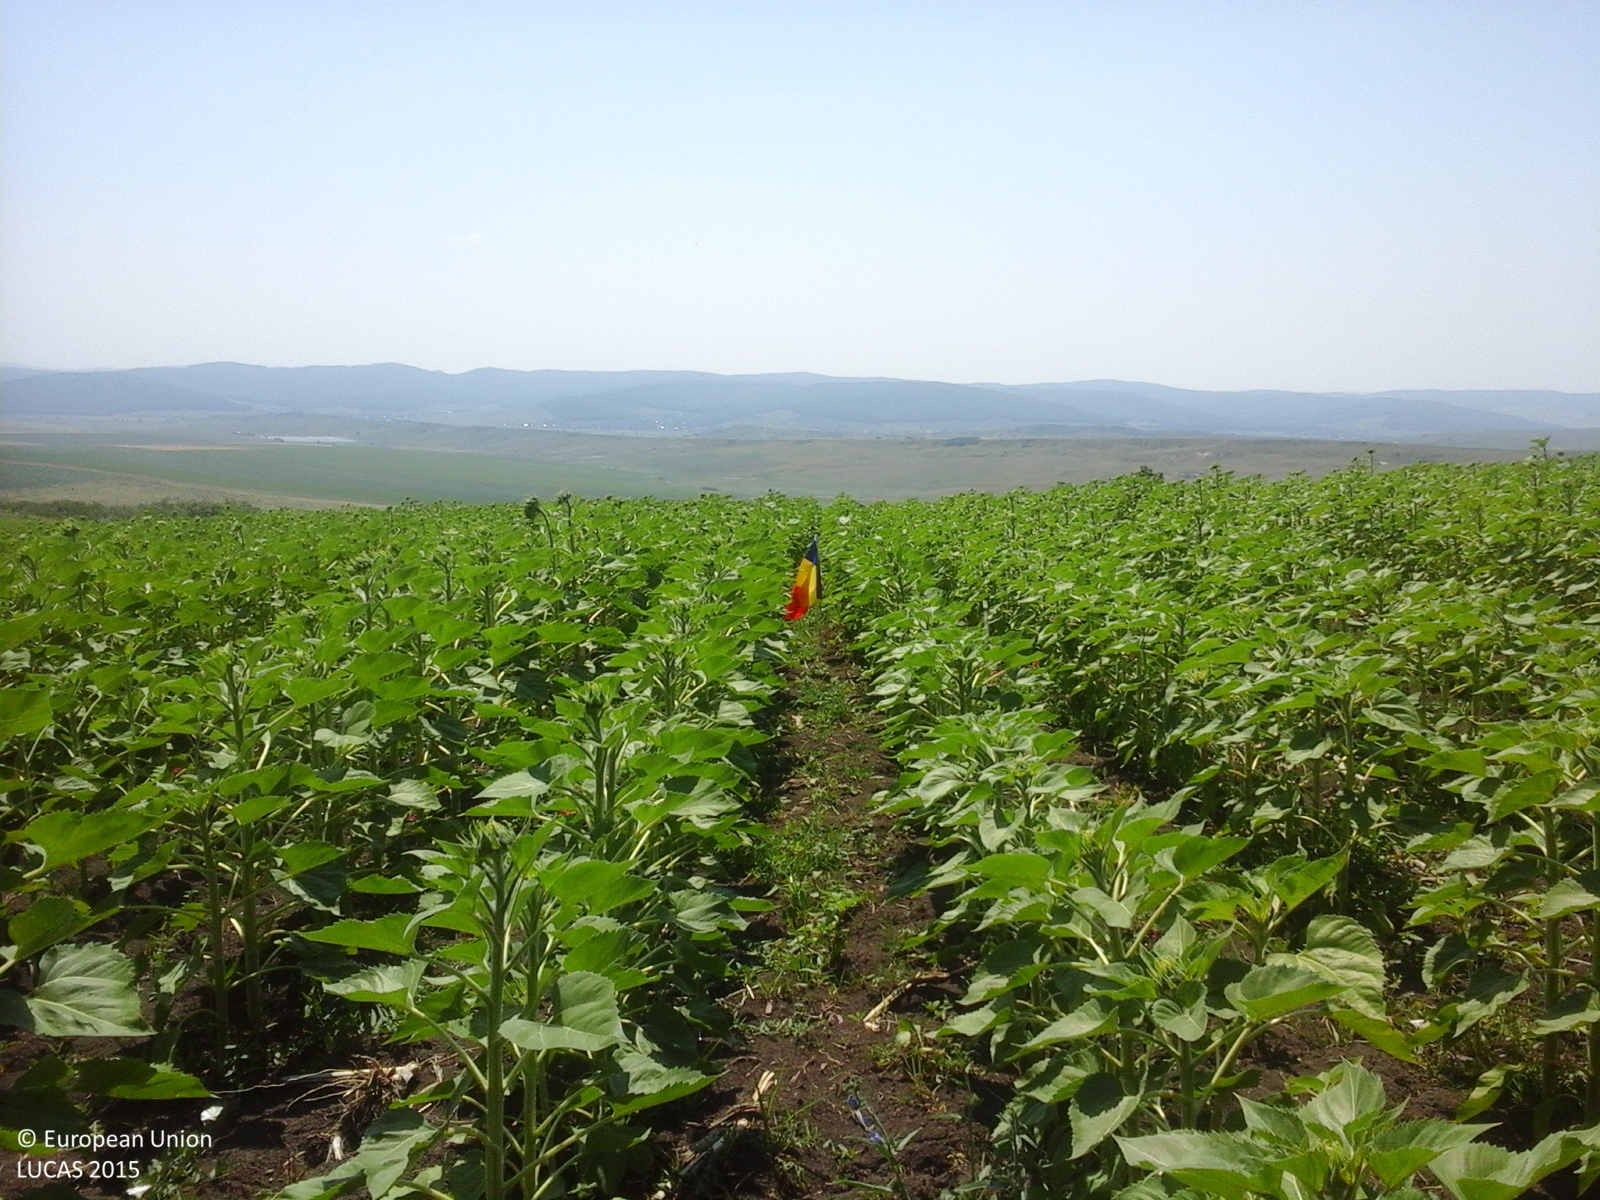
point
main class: Cropland
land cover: Sunflower
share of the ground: > 75 %
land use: Agriculture (excluding fallow land and kitchen gardens)
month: June
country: RO
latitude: 46.8985
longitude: 27.2898
